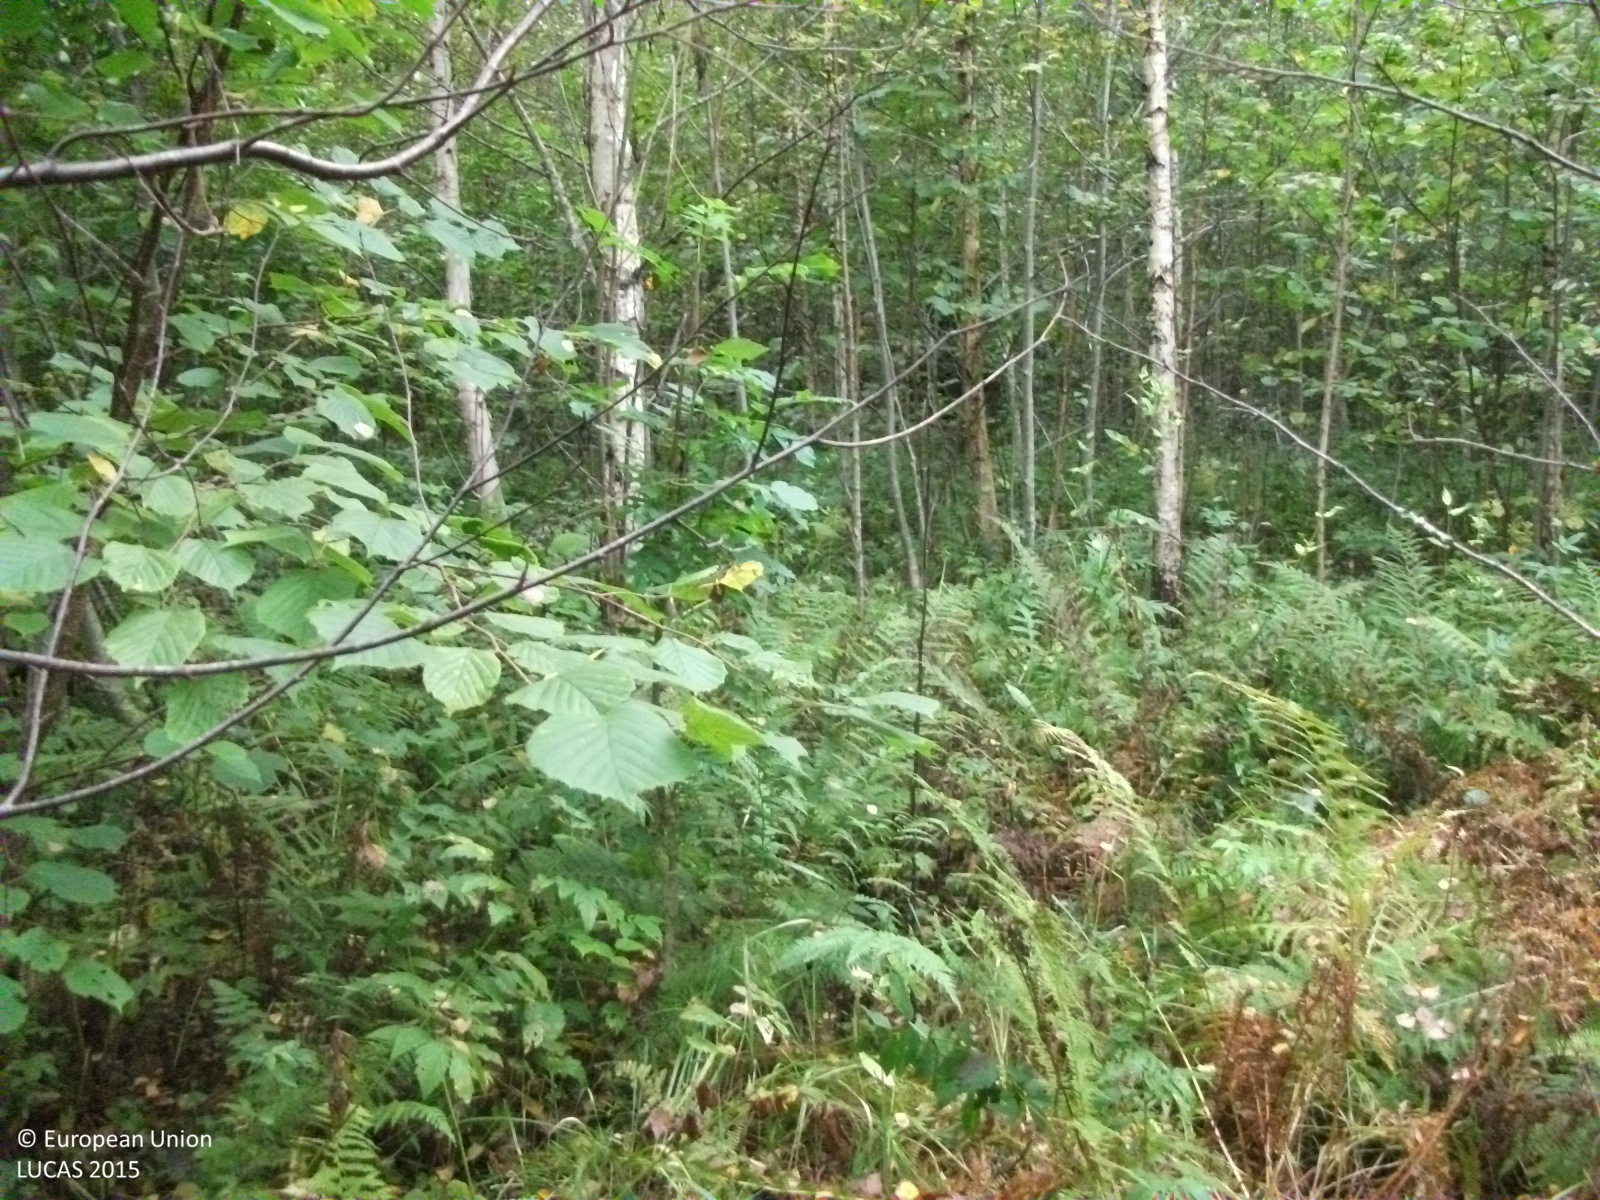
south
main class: Woodland
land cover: Broadleaved woodland
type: non-riverine alder, birch or aspen forest
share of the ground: > 75 %
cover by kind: broadleaved forest trees 80 %, shrubs 10 %, herbaceous plants 10 %
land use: Forestry
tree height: > 5 m
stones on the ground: < 10 %
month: September
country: LV
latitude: 57.6621
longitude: 24.6939
